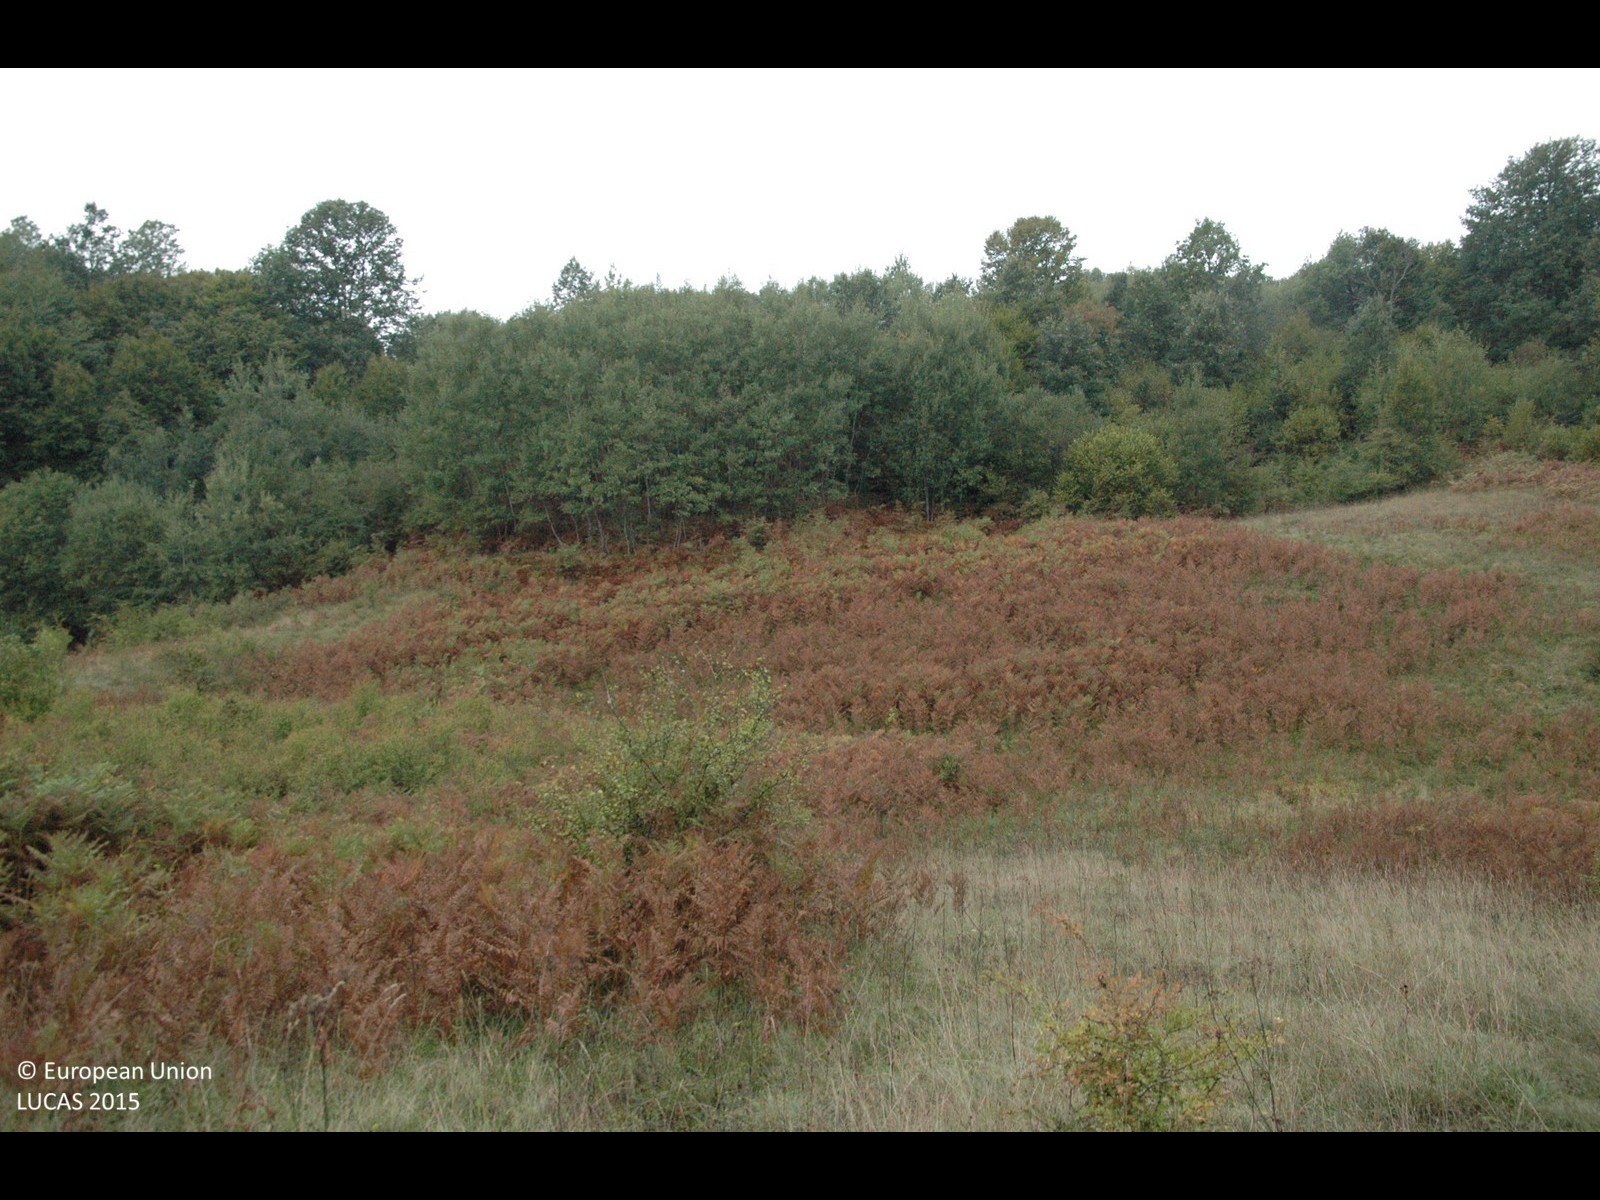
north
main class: Grassland
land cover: Grassland without tree/shrub cover
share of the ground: > 75 %
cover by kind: herbaceous plants 100 %
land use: Semi-natural and natural areas not in use
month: September
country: HR
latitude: 45.0463
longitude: 15.6449
